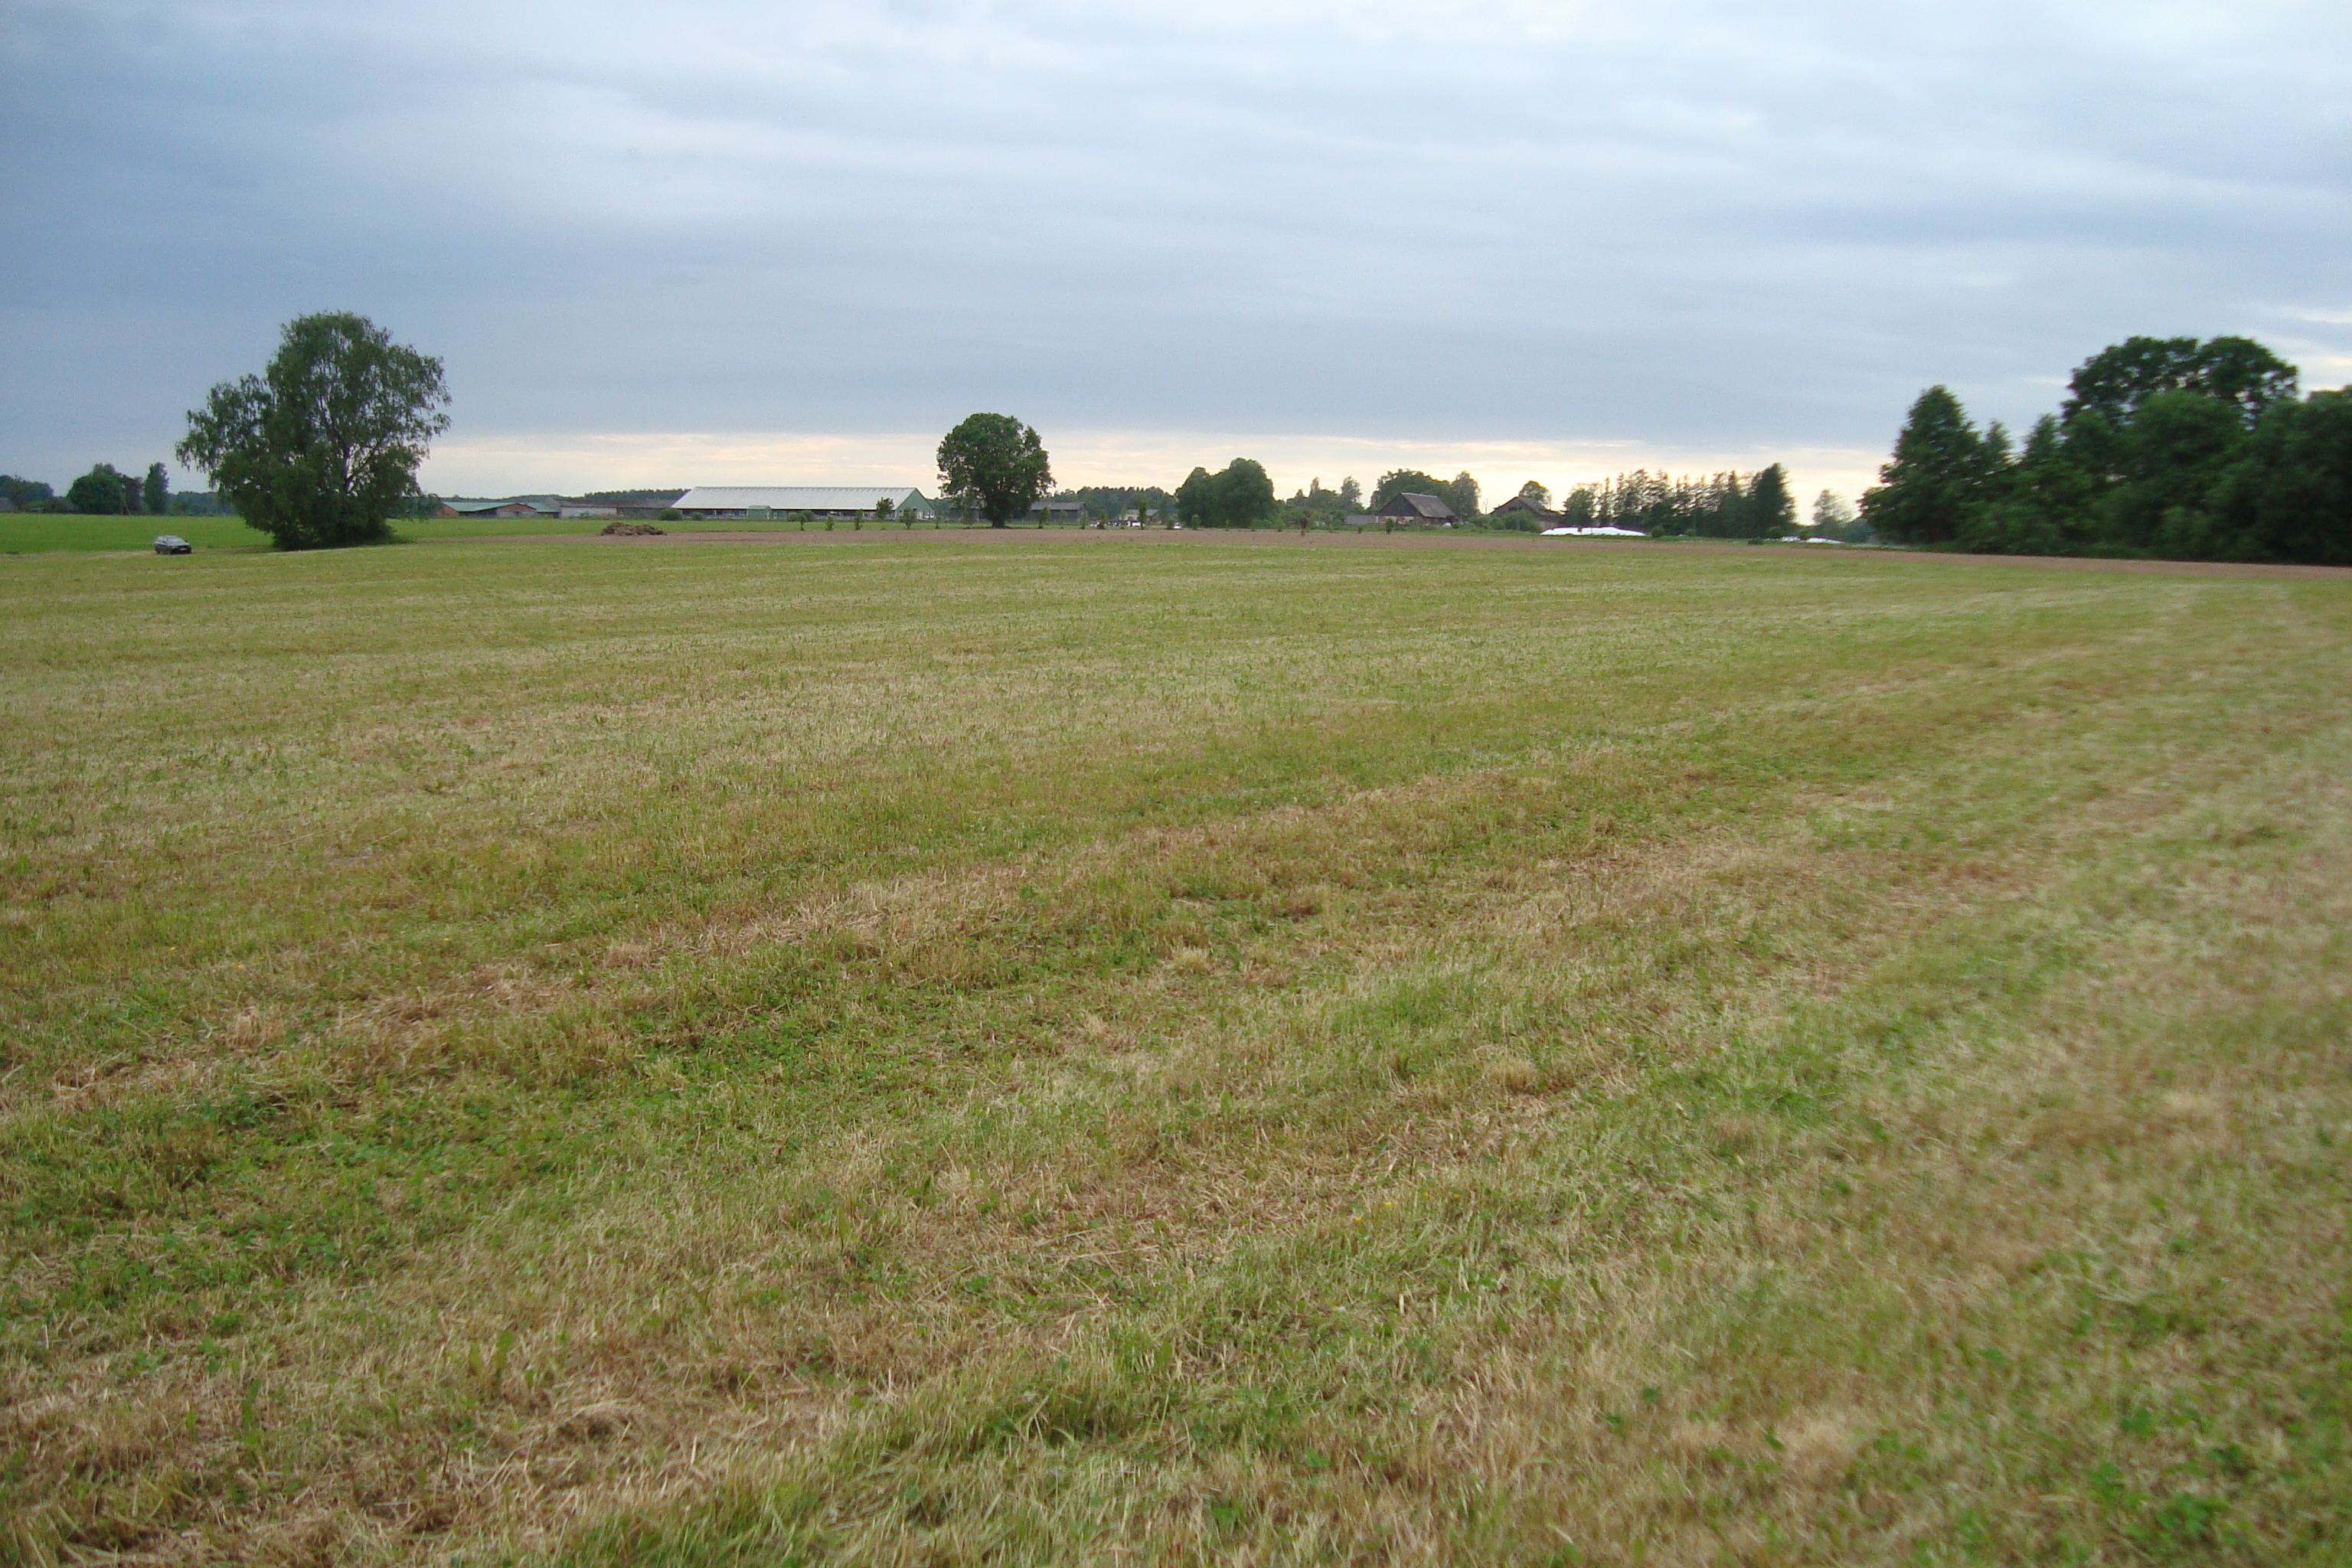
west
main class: Grassland
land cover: Grassland without tree/shrub cover
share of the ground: > 75 %
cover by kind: herbaceous plants 100 %
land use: Agriculture (excluding fallow land and kitchen gardens)
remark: Harvested field
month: June
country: LV
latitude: 57.2172
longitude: 26.4196
